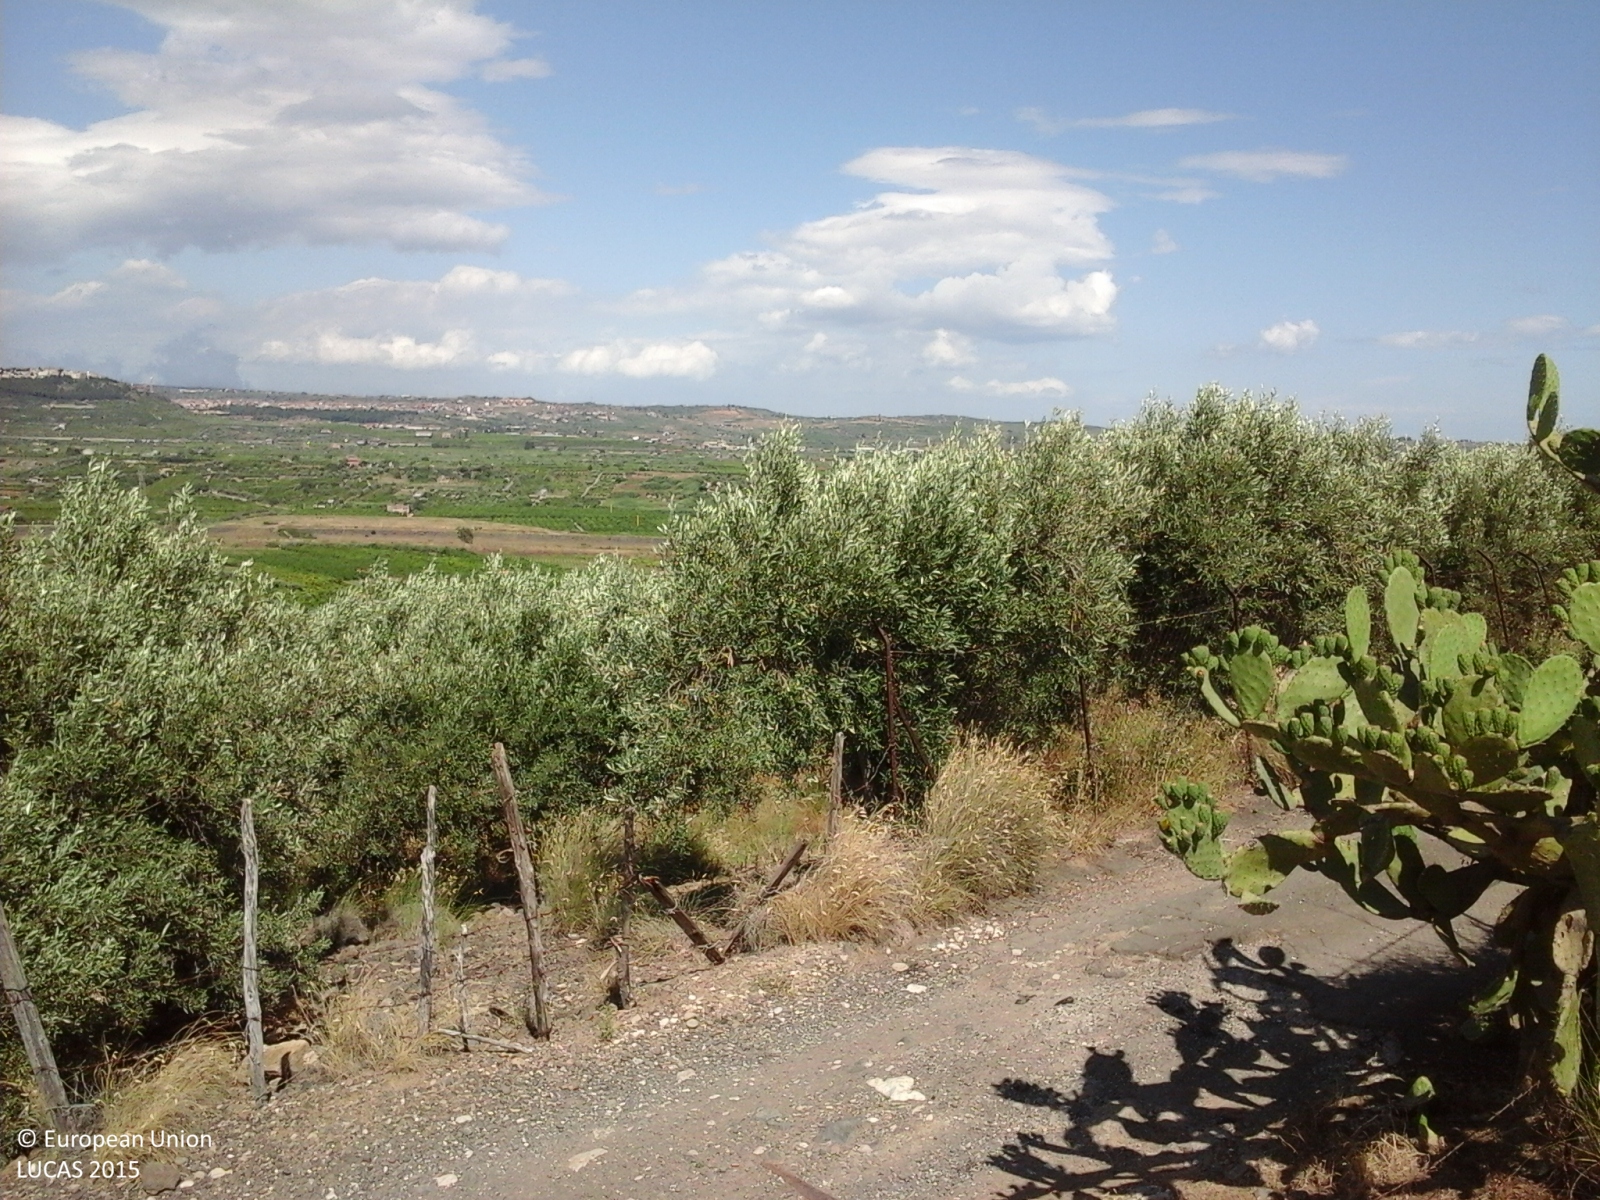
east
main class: Grassland
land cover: Grassland without tree/shrub cover
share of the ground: > 75 %
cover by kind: herbaceous plants 95 %, shrubs 5 %
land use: Agriculture (excluding fallow land and kitchen gardens)
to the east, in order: Grassland without tree/shrub cover
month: June
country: IT
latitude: 37.5513
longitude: 14.8438
